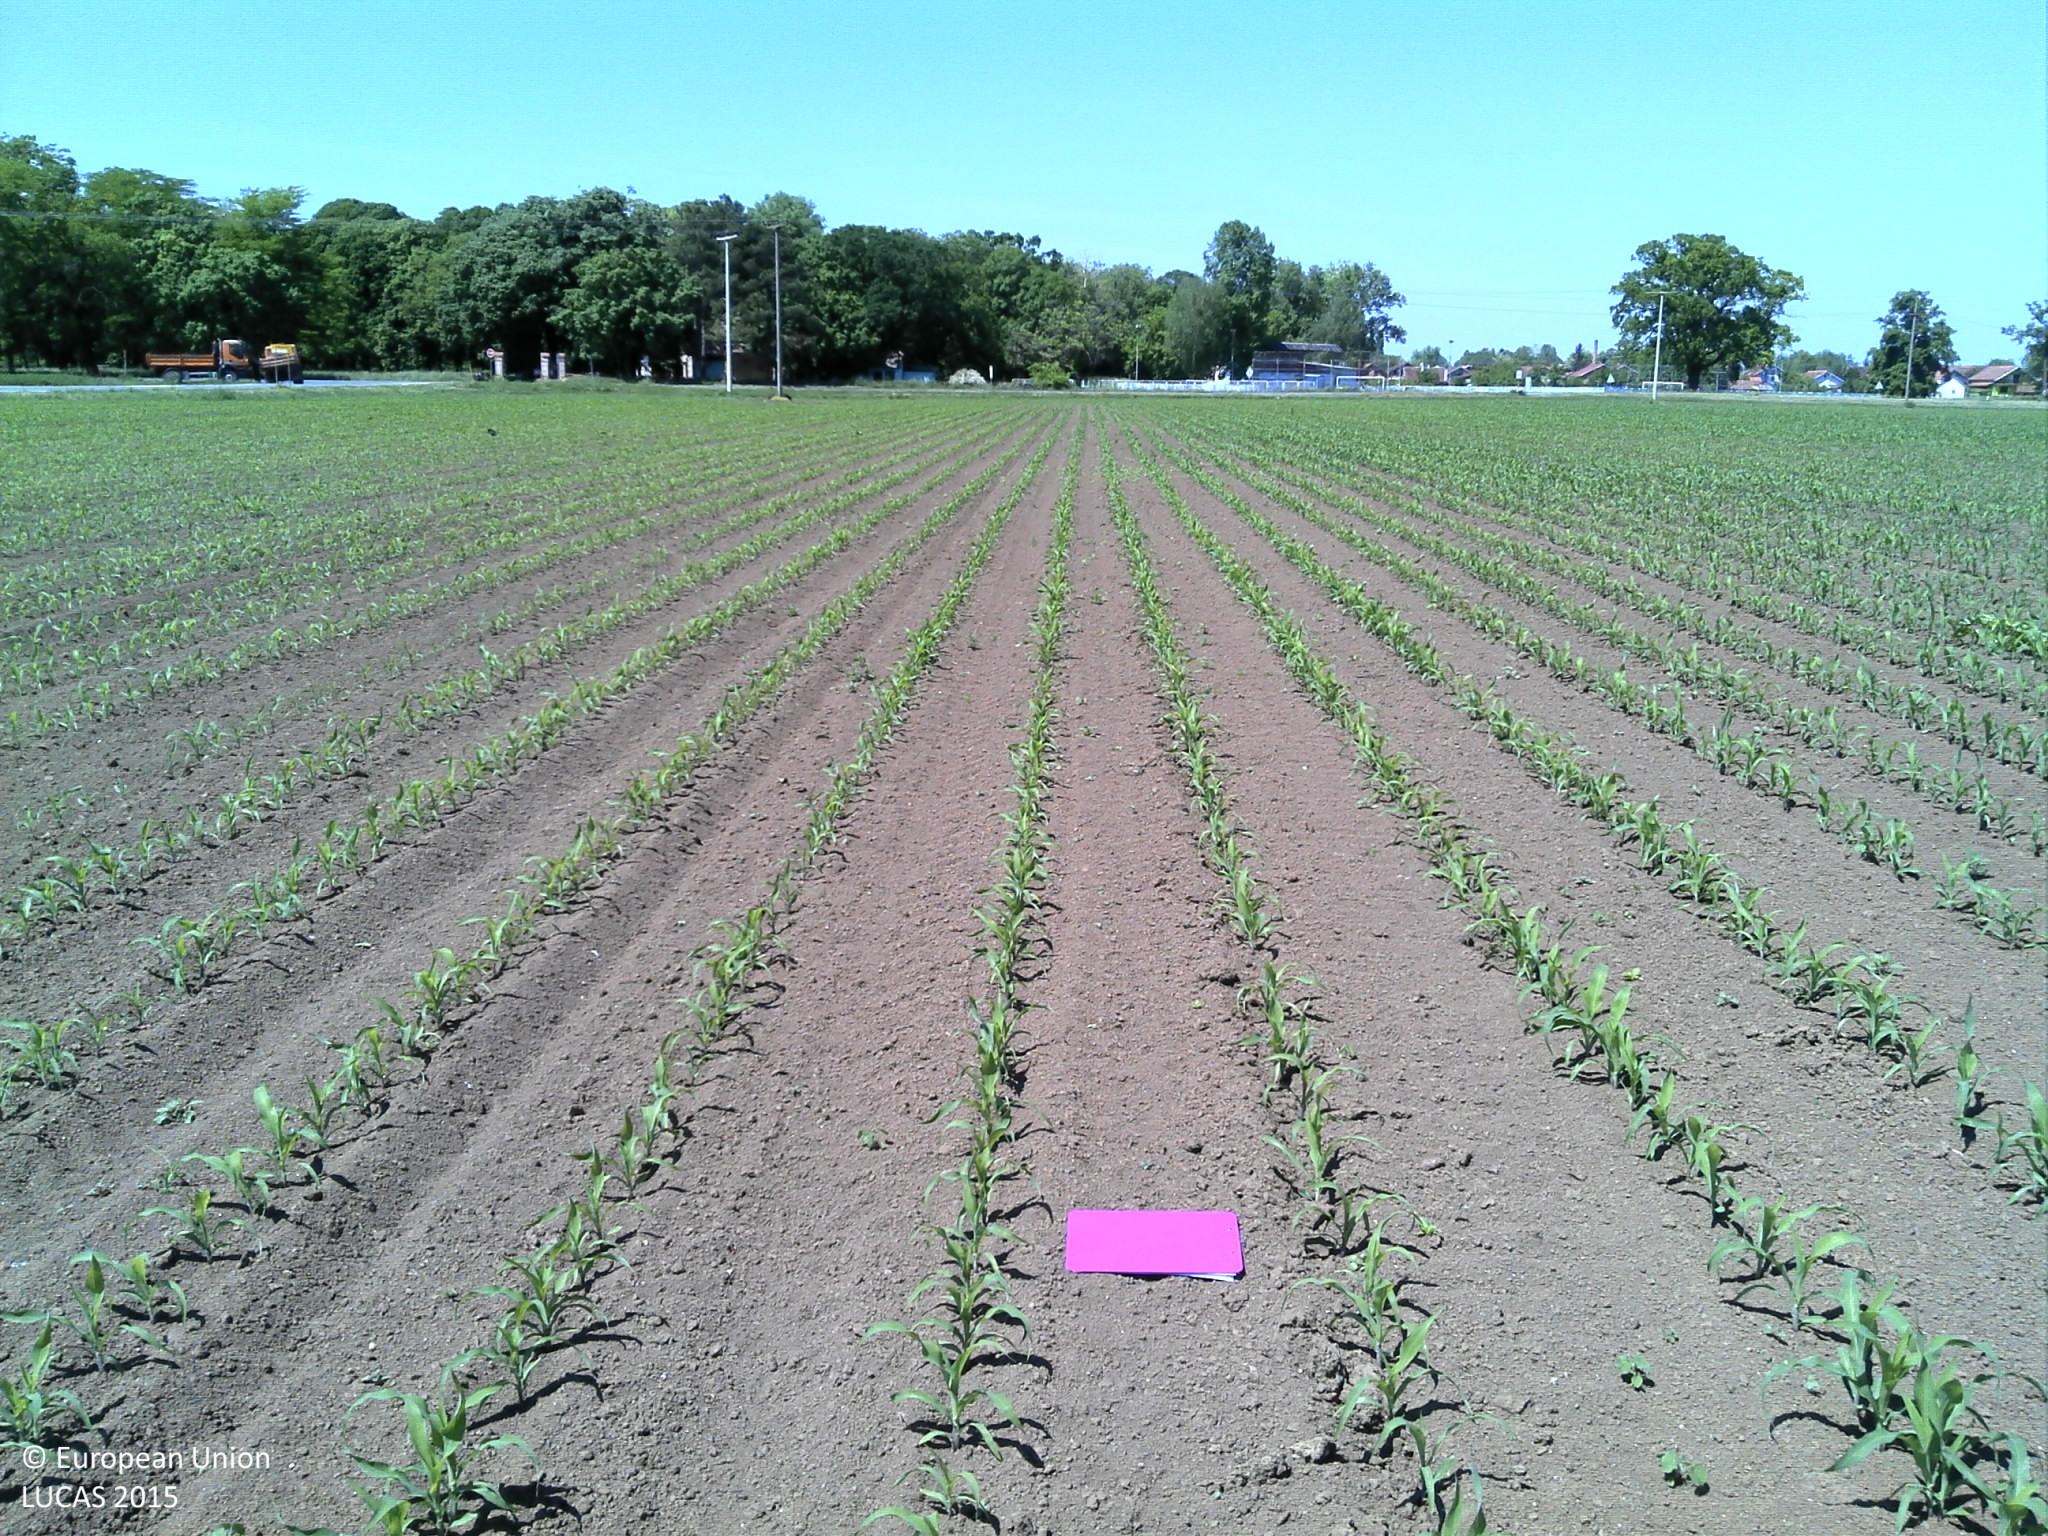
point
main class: Cropland
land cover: Maize
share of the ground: < 10 %
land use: Agriculture (excluding fallow land and kitchen gardens)
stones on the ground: < 10 %
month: May
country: HR
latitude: 45.8375
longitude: 18.6476
